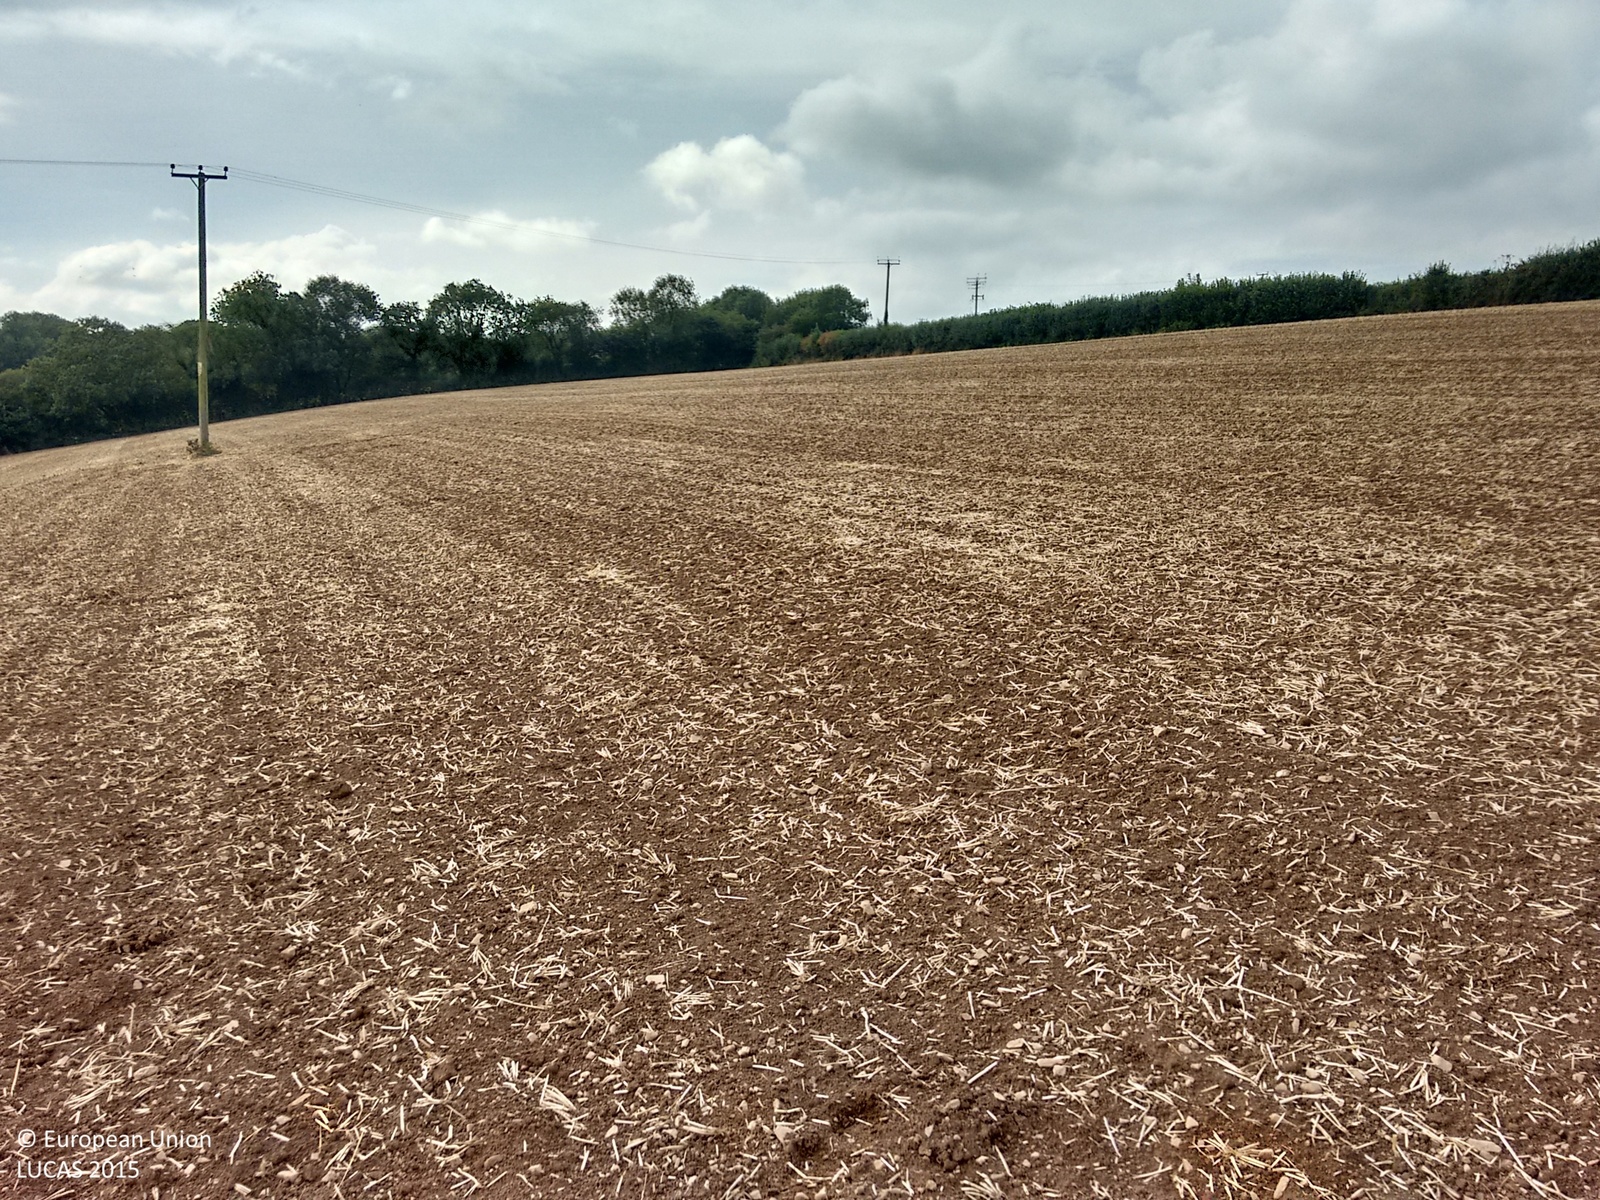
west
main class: Cropland
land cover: Barley
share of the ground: 10 - 25 %
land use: Agriculture (excluding fallow land and kitchen gardens)
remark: Harvested field
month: September
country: GB
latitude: 50.7683
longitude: -4.3514
